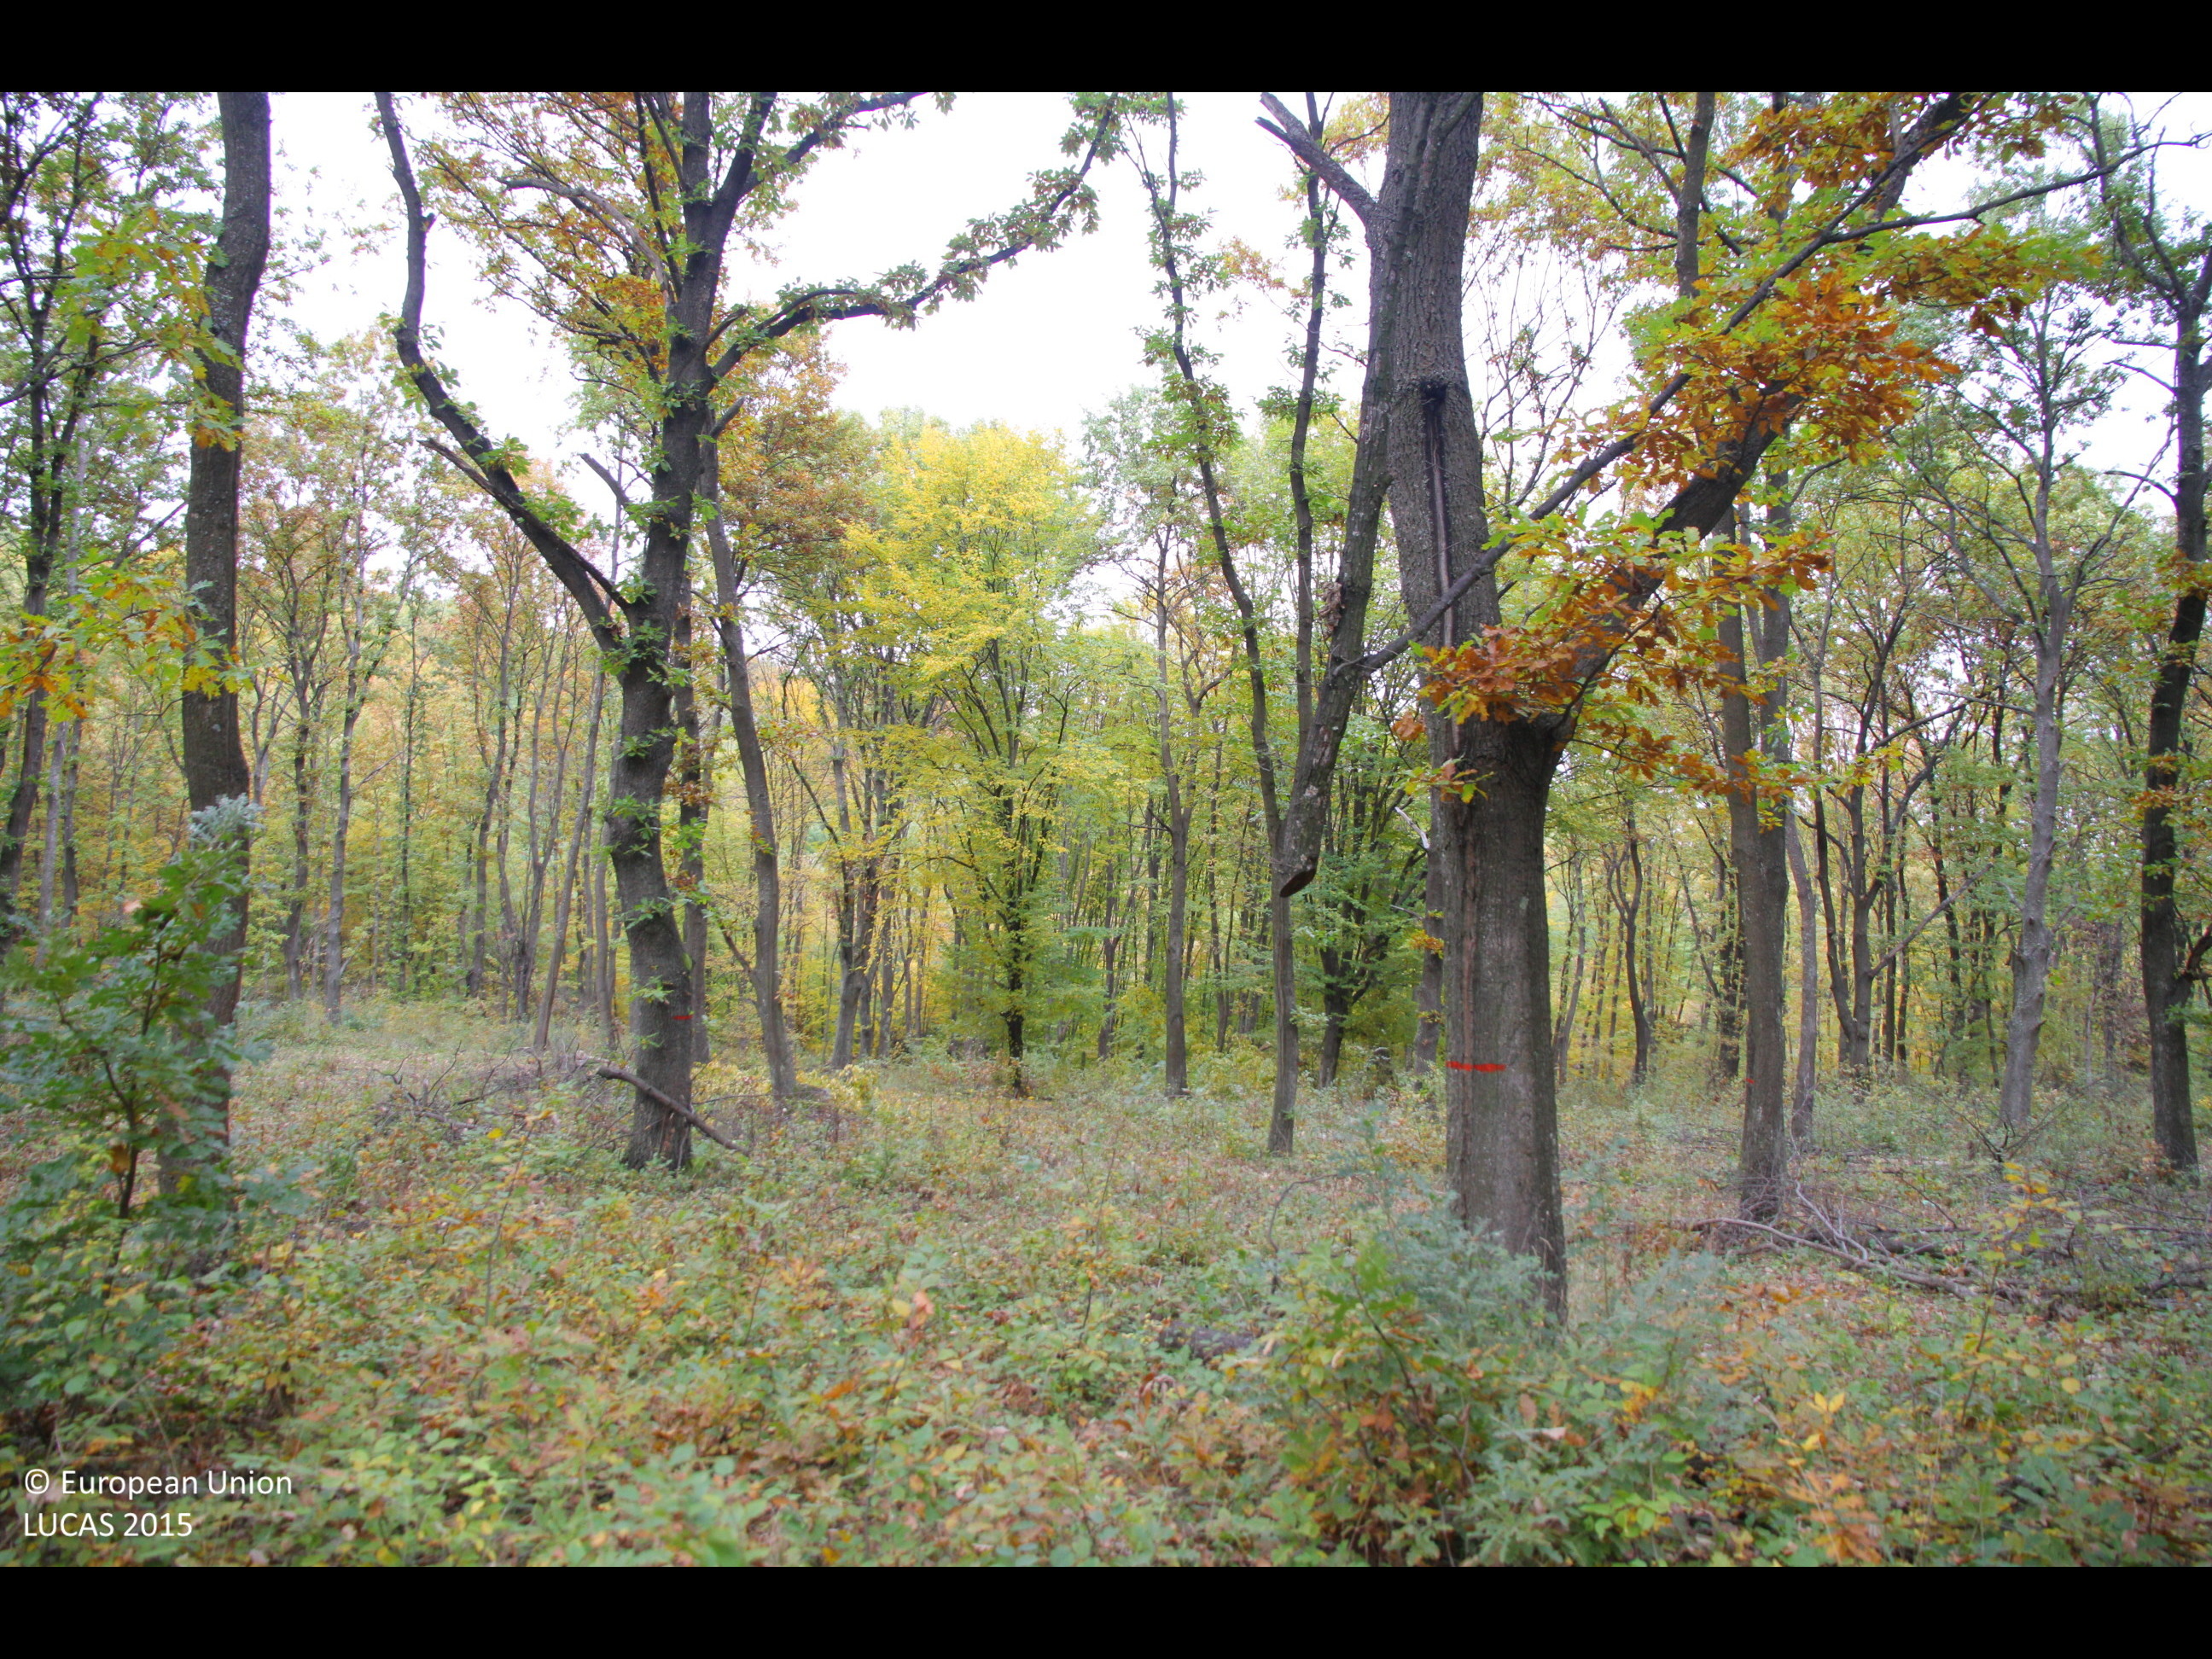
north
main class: Woodland
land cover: Broadleaved woodland
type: mesophytic deciduous forest
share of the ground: > 75 %
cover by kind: broadleaved forest trees 80 %, unconsolidated bare surface 10 %, shrubs 5 %, herbaceous plants 5 %
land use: Forestry
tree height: > 5 m
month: October
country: BG
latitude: 43.5244
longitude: 26.7776
